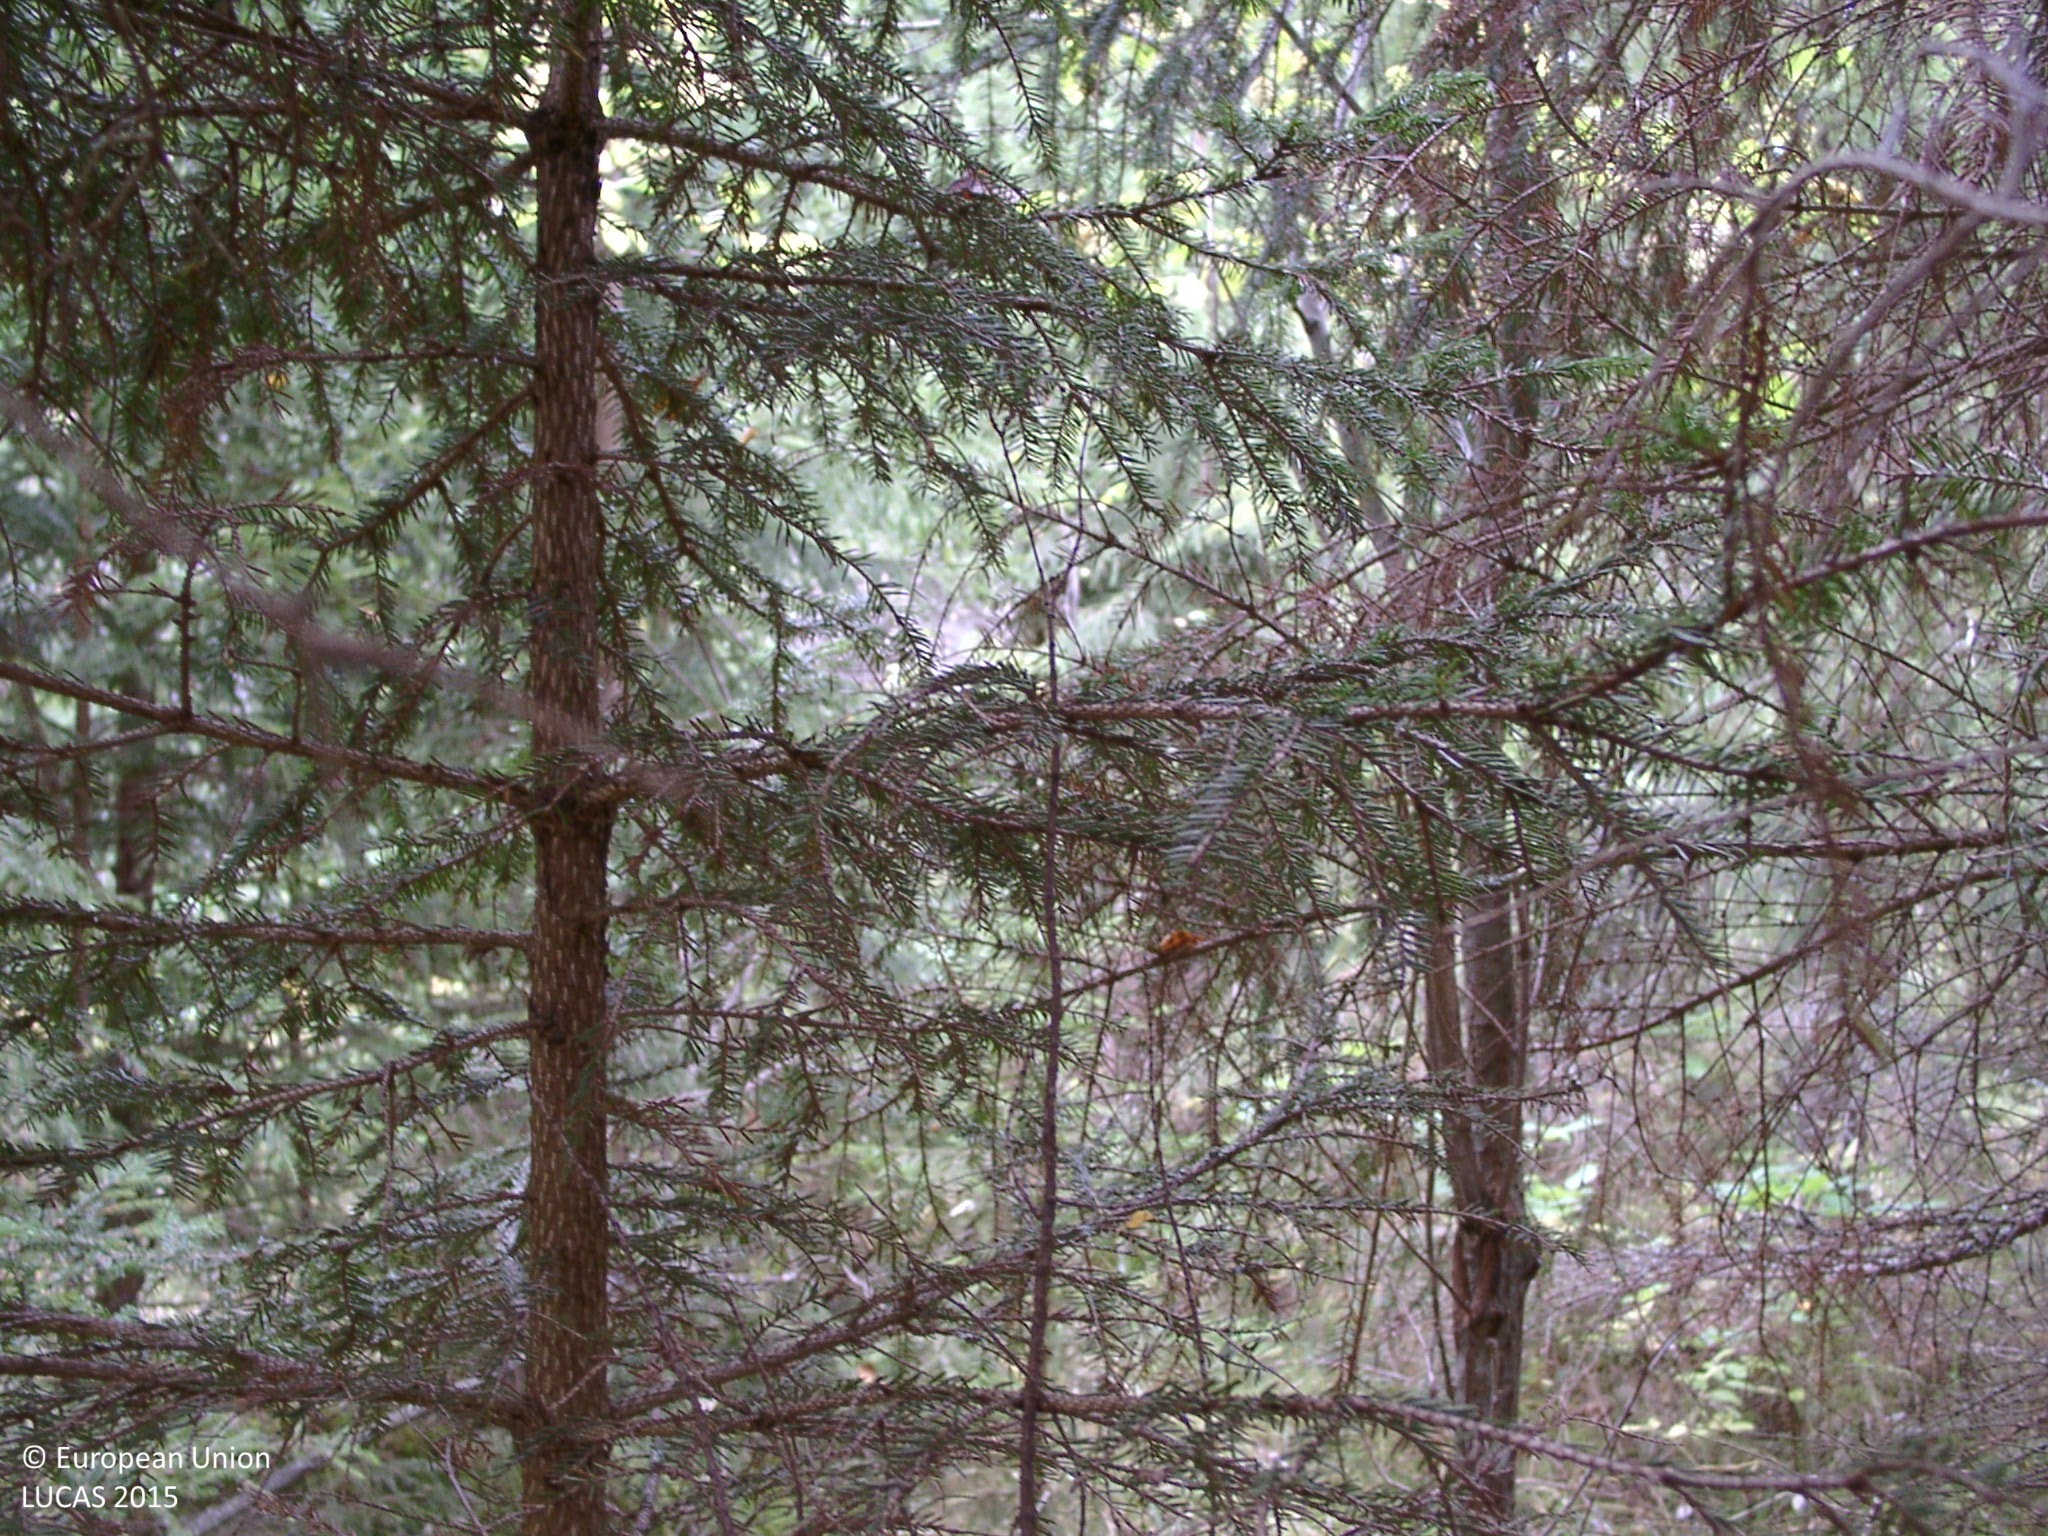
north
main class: Woodland
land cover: Spruce dominated coniferous woodland
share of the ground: > 75 %
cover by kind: coniferous forest trees 85 %, shrubs 5 %, herbaceous plants 5 %, lichens and mosses 5 %
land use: Forestry
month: September
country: FI
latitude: 62.6312
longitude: 25.3347
